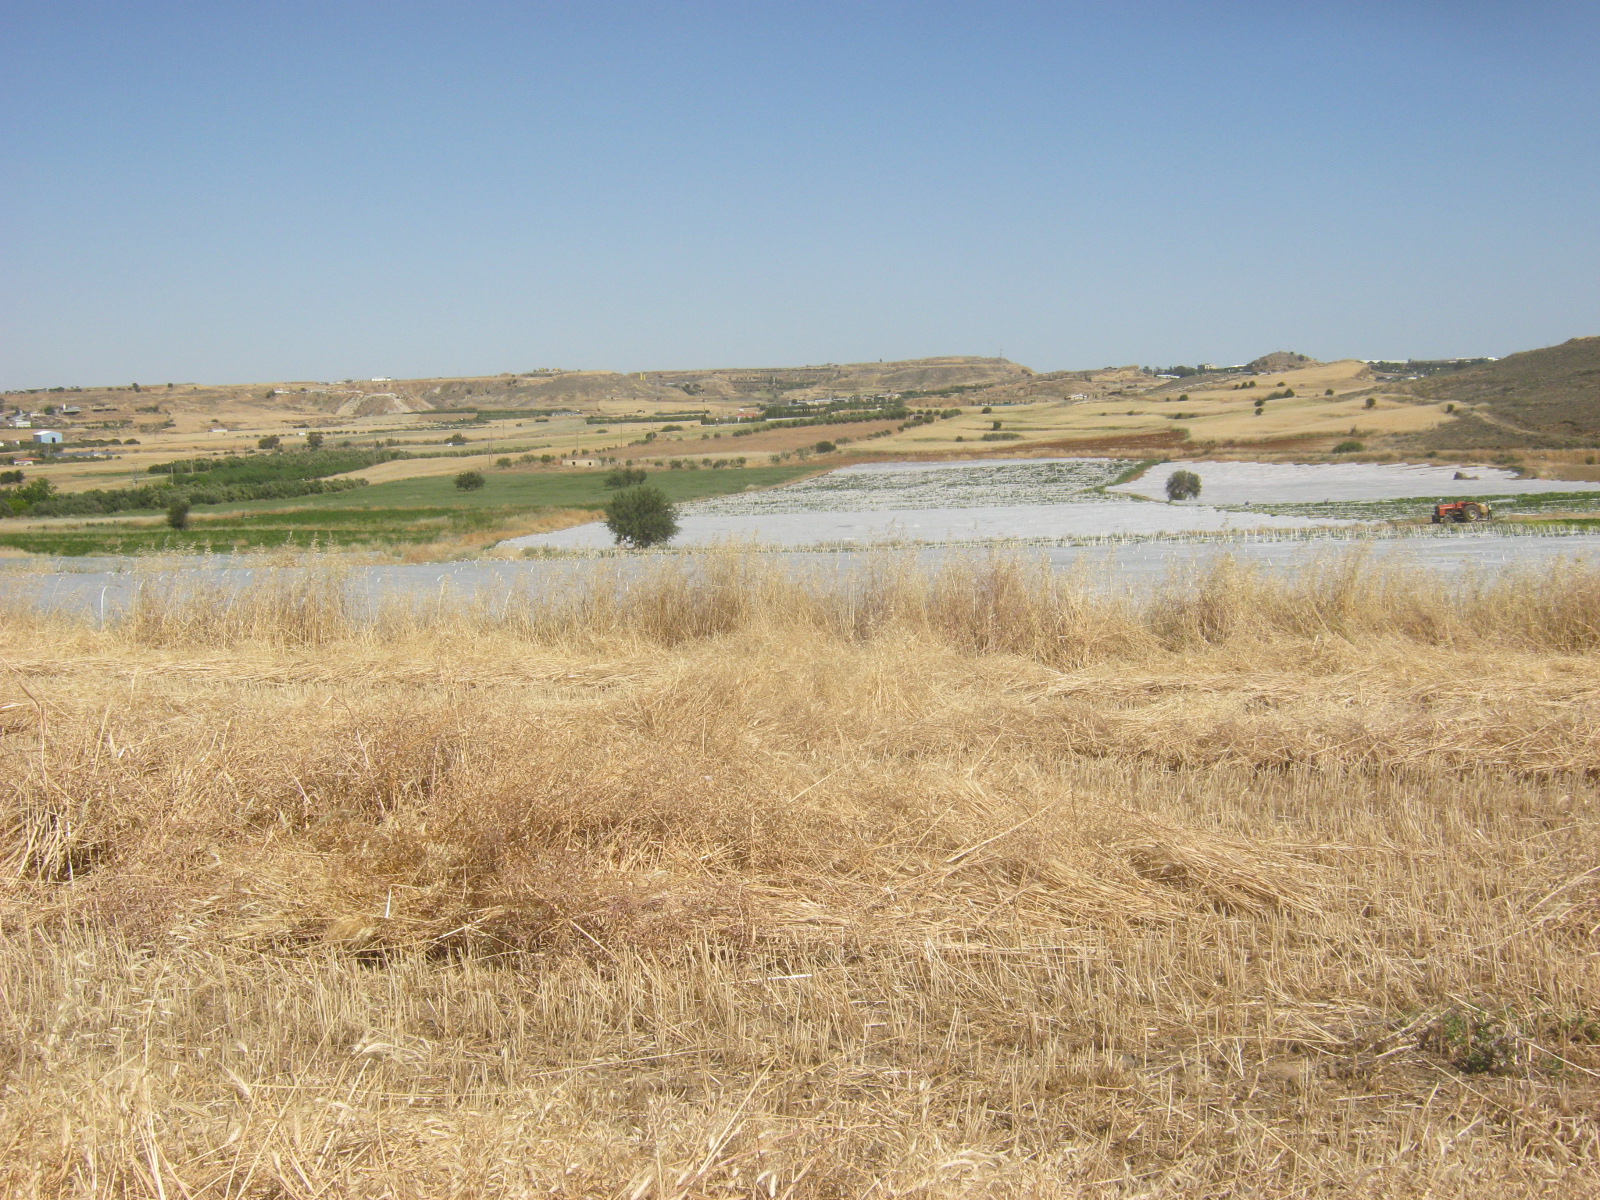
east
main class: Cropland
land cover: Barley
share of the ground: < 10 %
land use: Agriculture (excluding fallow land and kitchen gardens)
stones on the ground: < 10 %
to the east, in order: Barley; Tracks; Grass margins; Other fresh vegetables; Tracks; Potatoes; Other root crops
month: May
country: CY
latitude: 35.0790
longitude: 33.2050
